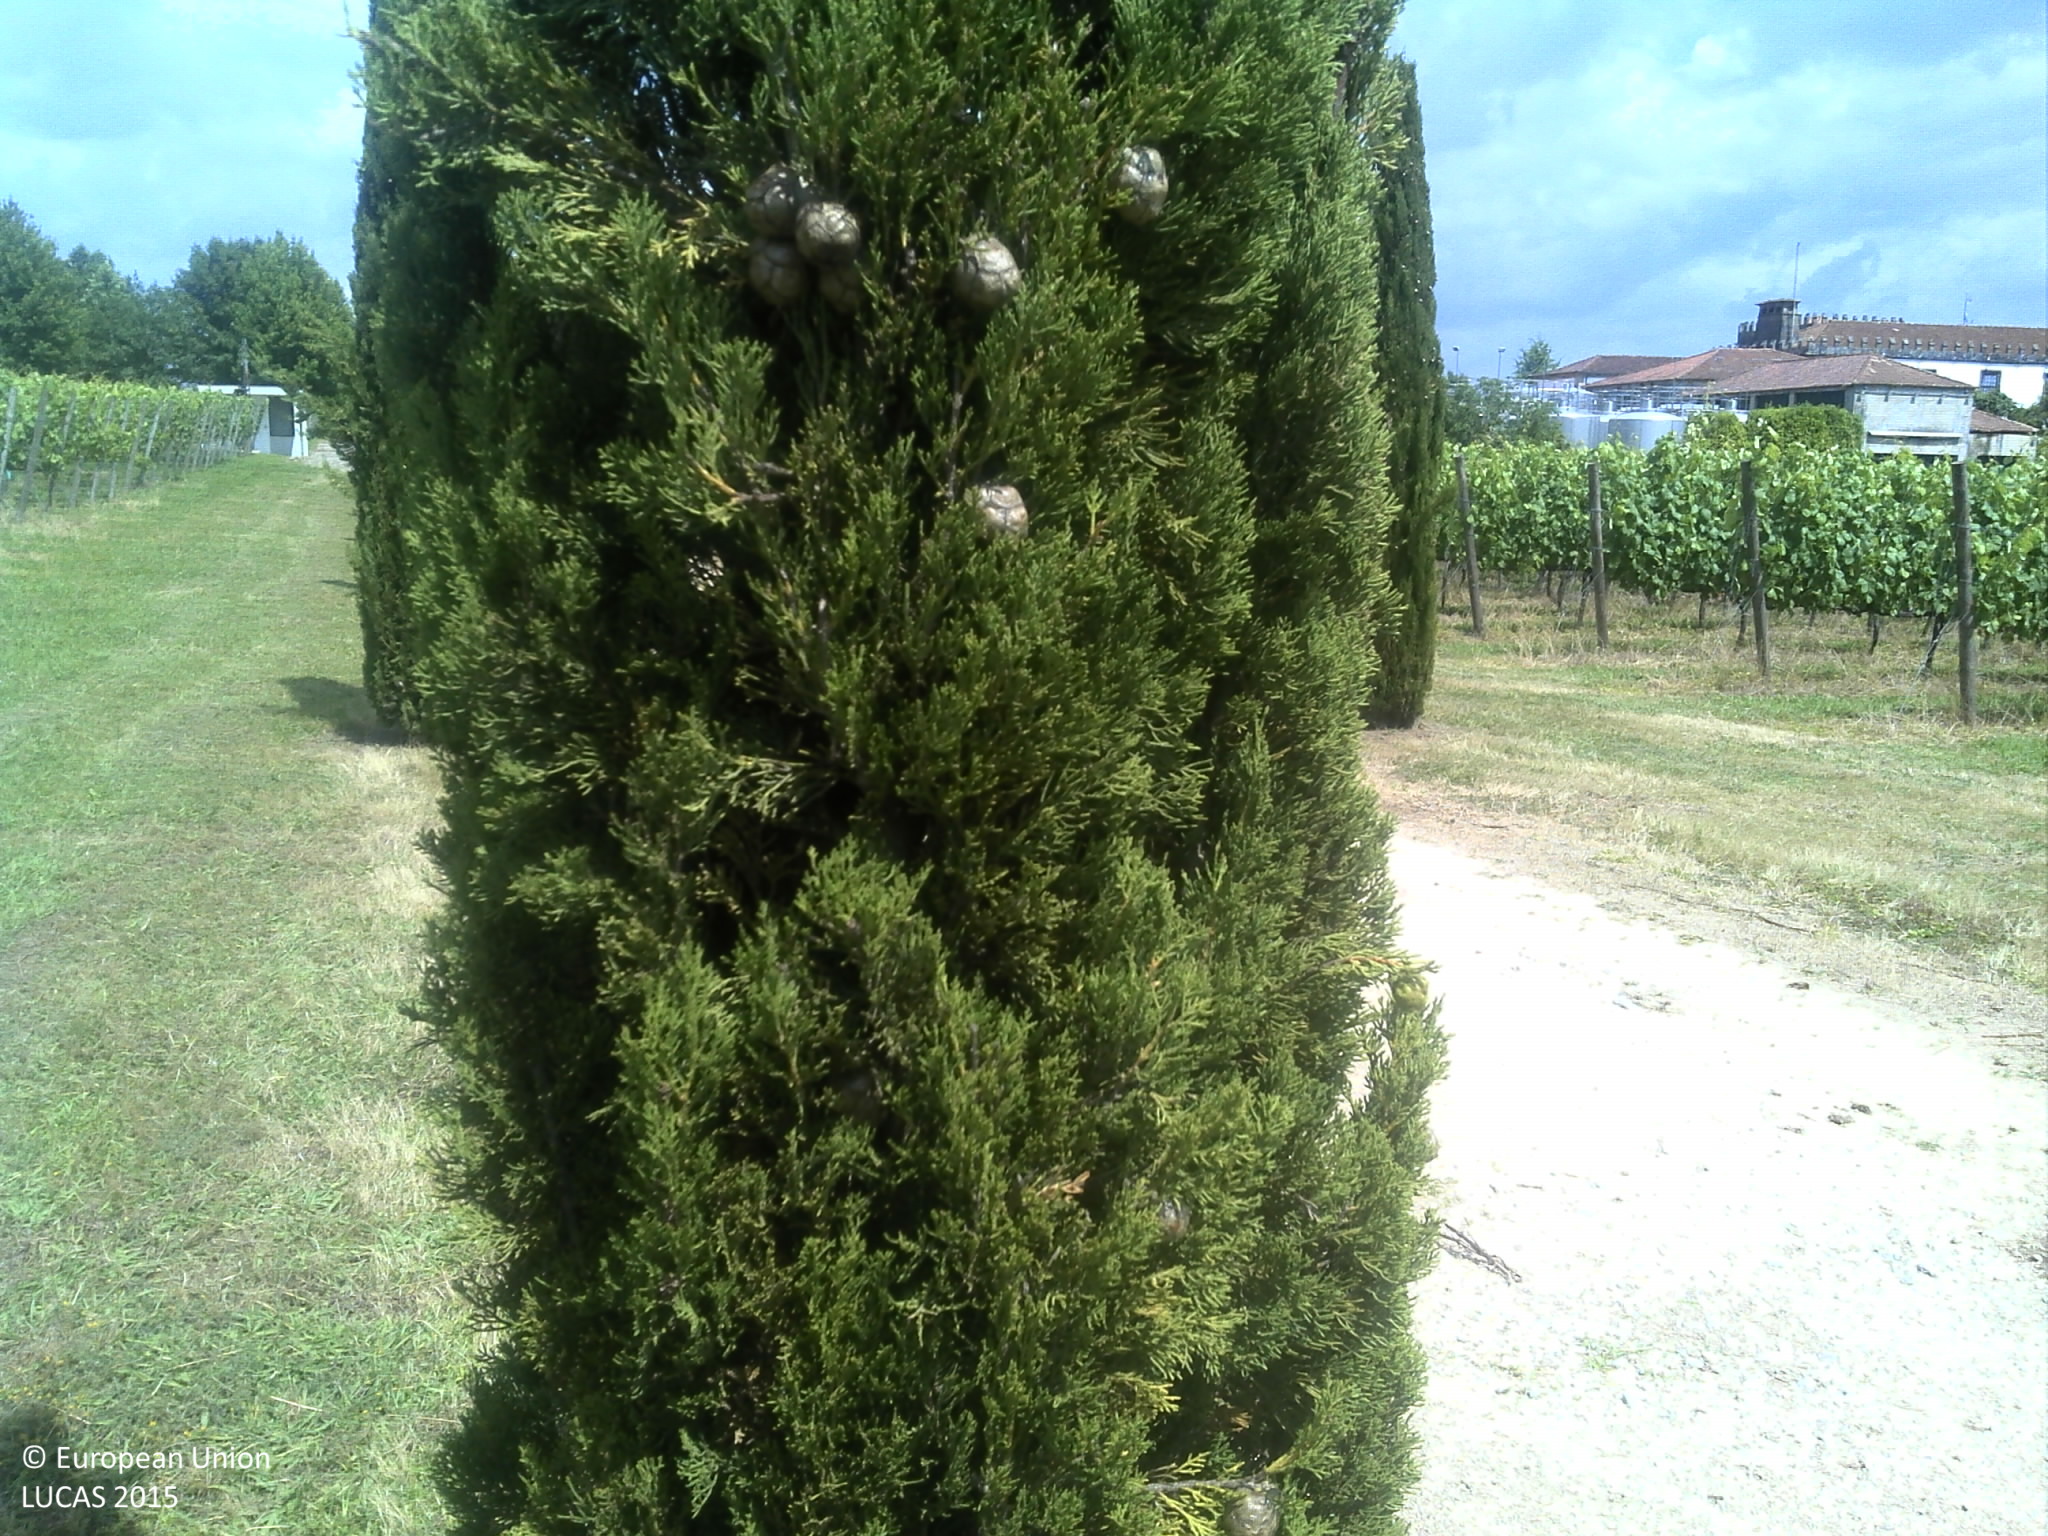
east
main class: Grassland
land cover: Grassland without tree/shrub cover
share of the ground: > 75 %
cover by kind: herbaceous plants 85 %, unconsolidated bare surface 15 %
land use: Agriculture (excluding fallow land and kitchen gardens)
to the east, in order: Lines of trees; Grassland without tree/shrub cover; Tracks; Lines of trees; Grassland without tree/shrub cover; Paved roads, cycling and walking lanes; Broadleaved woodland; Grassland without tree/shrub cover; Broadleaved woodland; Lines of trees; Paved roads, cycling and walking lanes; Managed hedges; Olive groves; Dry stone walls; Oranges; Dry stone walls; Paved roads, cycling and walking lanes; Dry stone walls; Other fruit trees and berries; Tracks; Vineyards
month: June
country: PT
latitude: 41.5710
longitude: -8.5423
